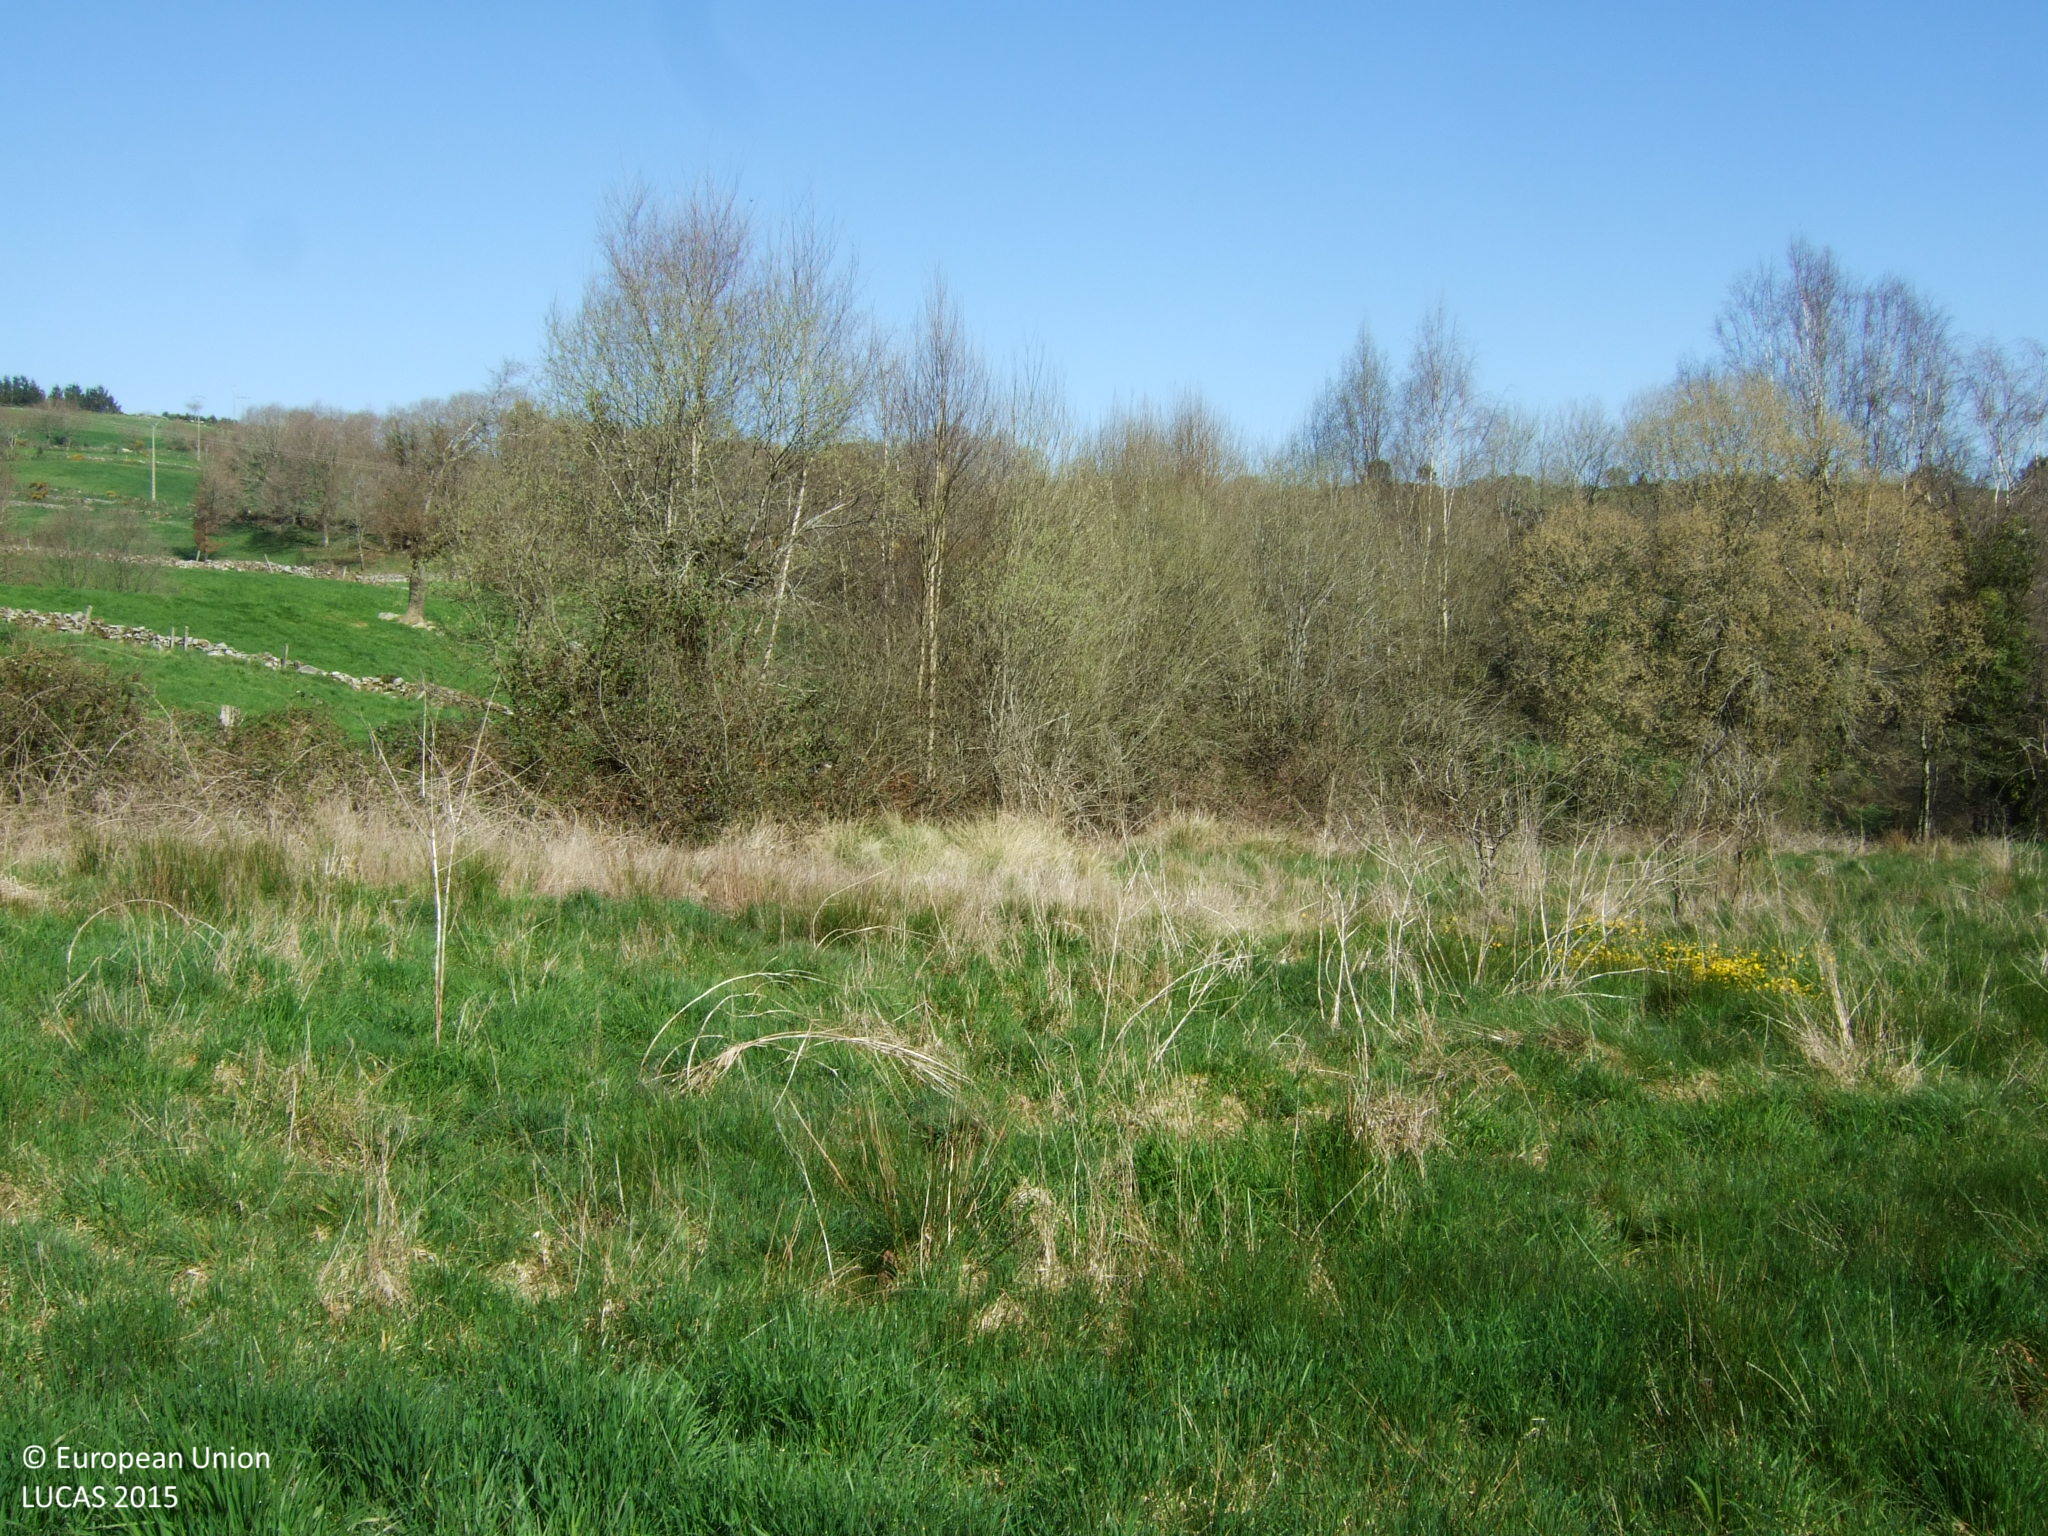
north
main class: Grassland
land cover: Grassland without tree/shrub cover
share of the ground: > 75 %
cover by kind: herbaceous plants 100 %
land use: Agriculture (excluding fallow land and kitchen gardens)
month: April
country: ES
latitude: 42.6965
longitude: -7.8422
